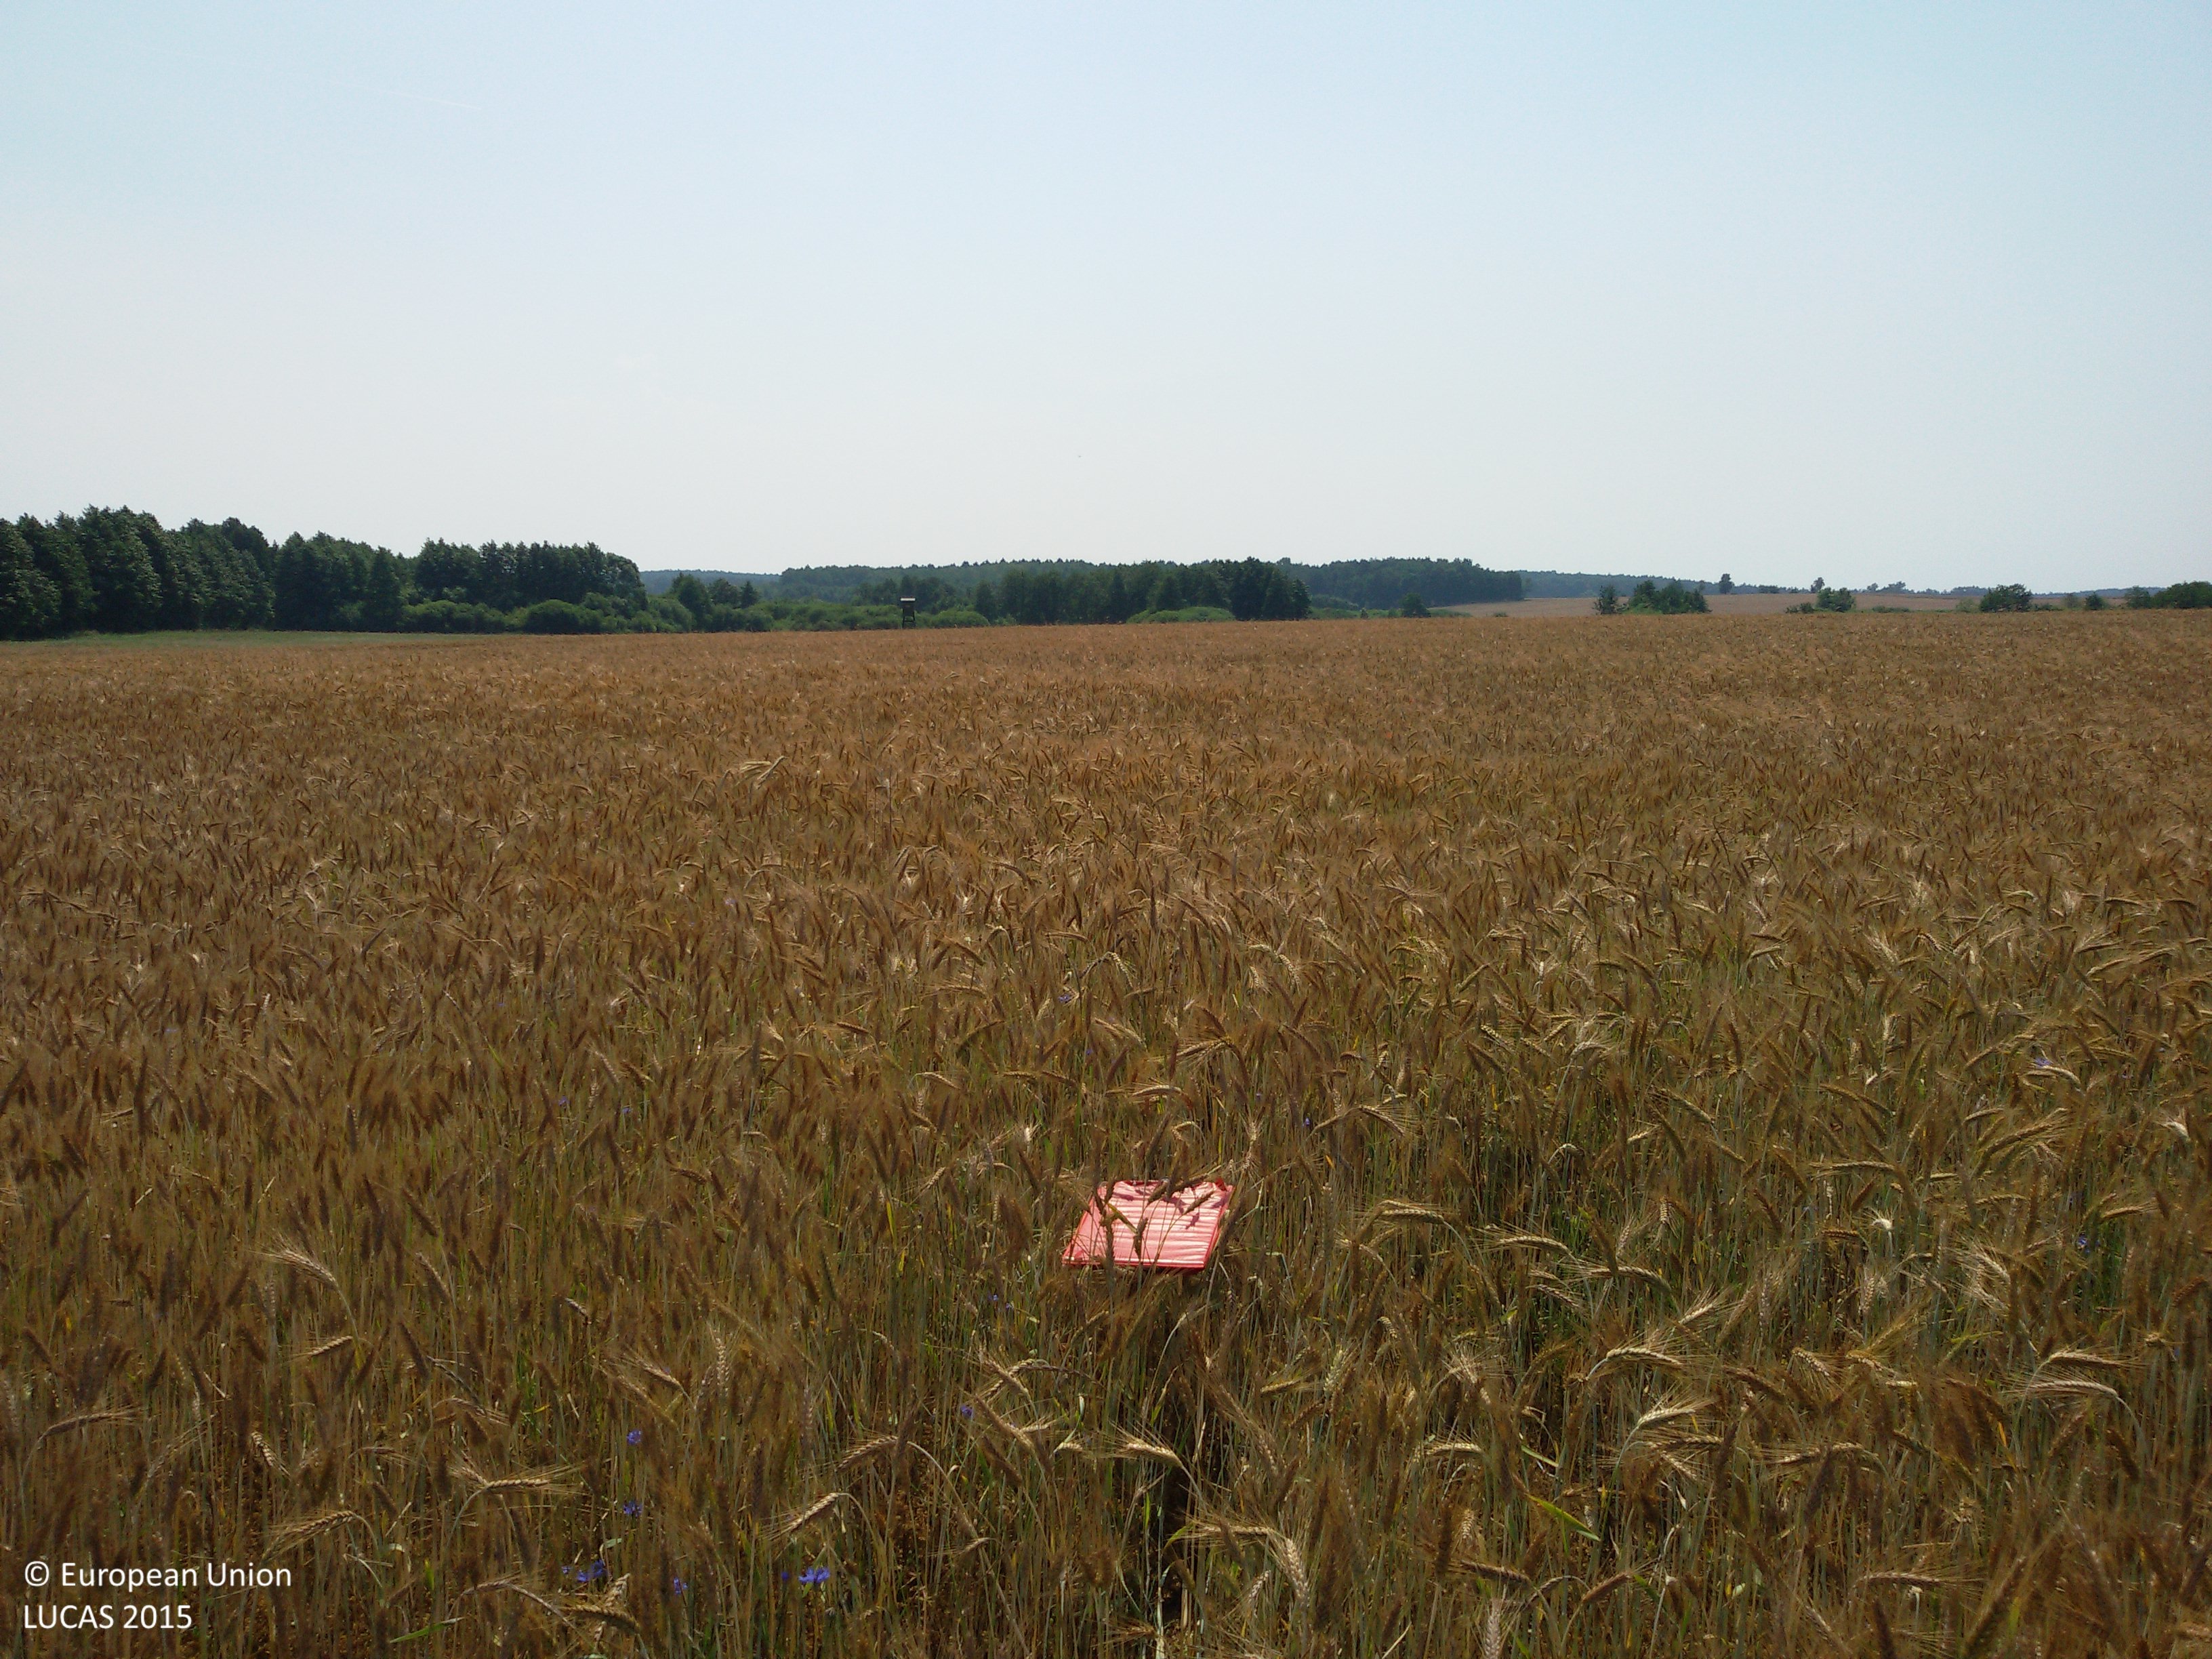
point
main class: Cropland
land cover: Triticale
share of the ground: > 75 %
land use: Agriculture (excluding fallow land and kitchen gardens)
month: July
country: PL
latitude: 53.3042
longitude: 17.6510
